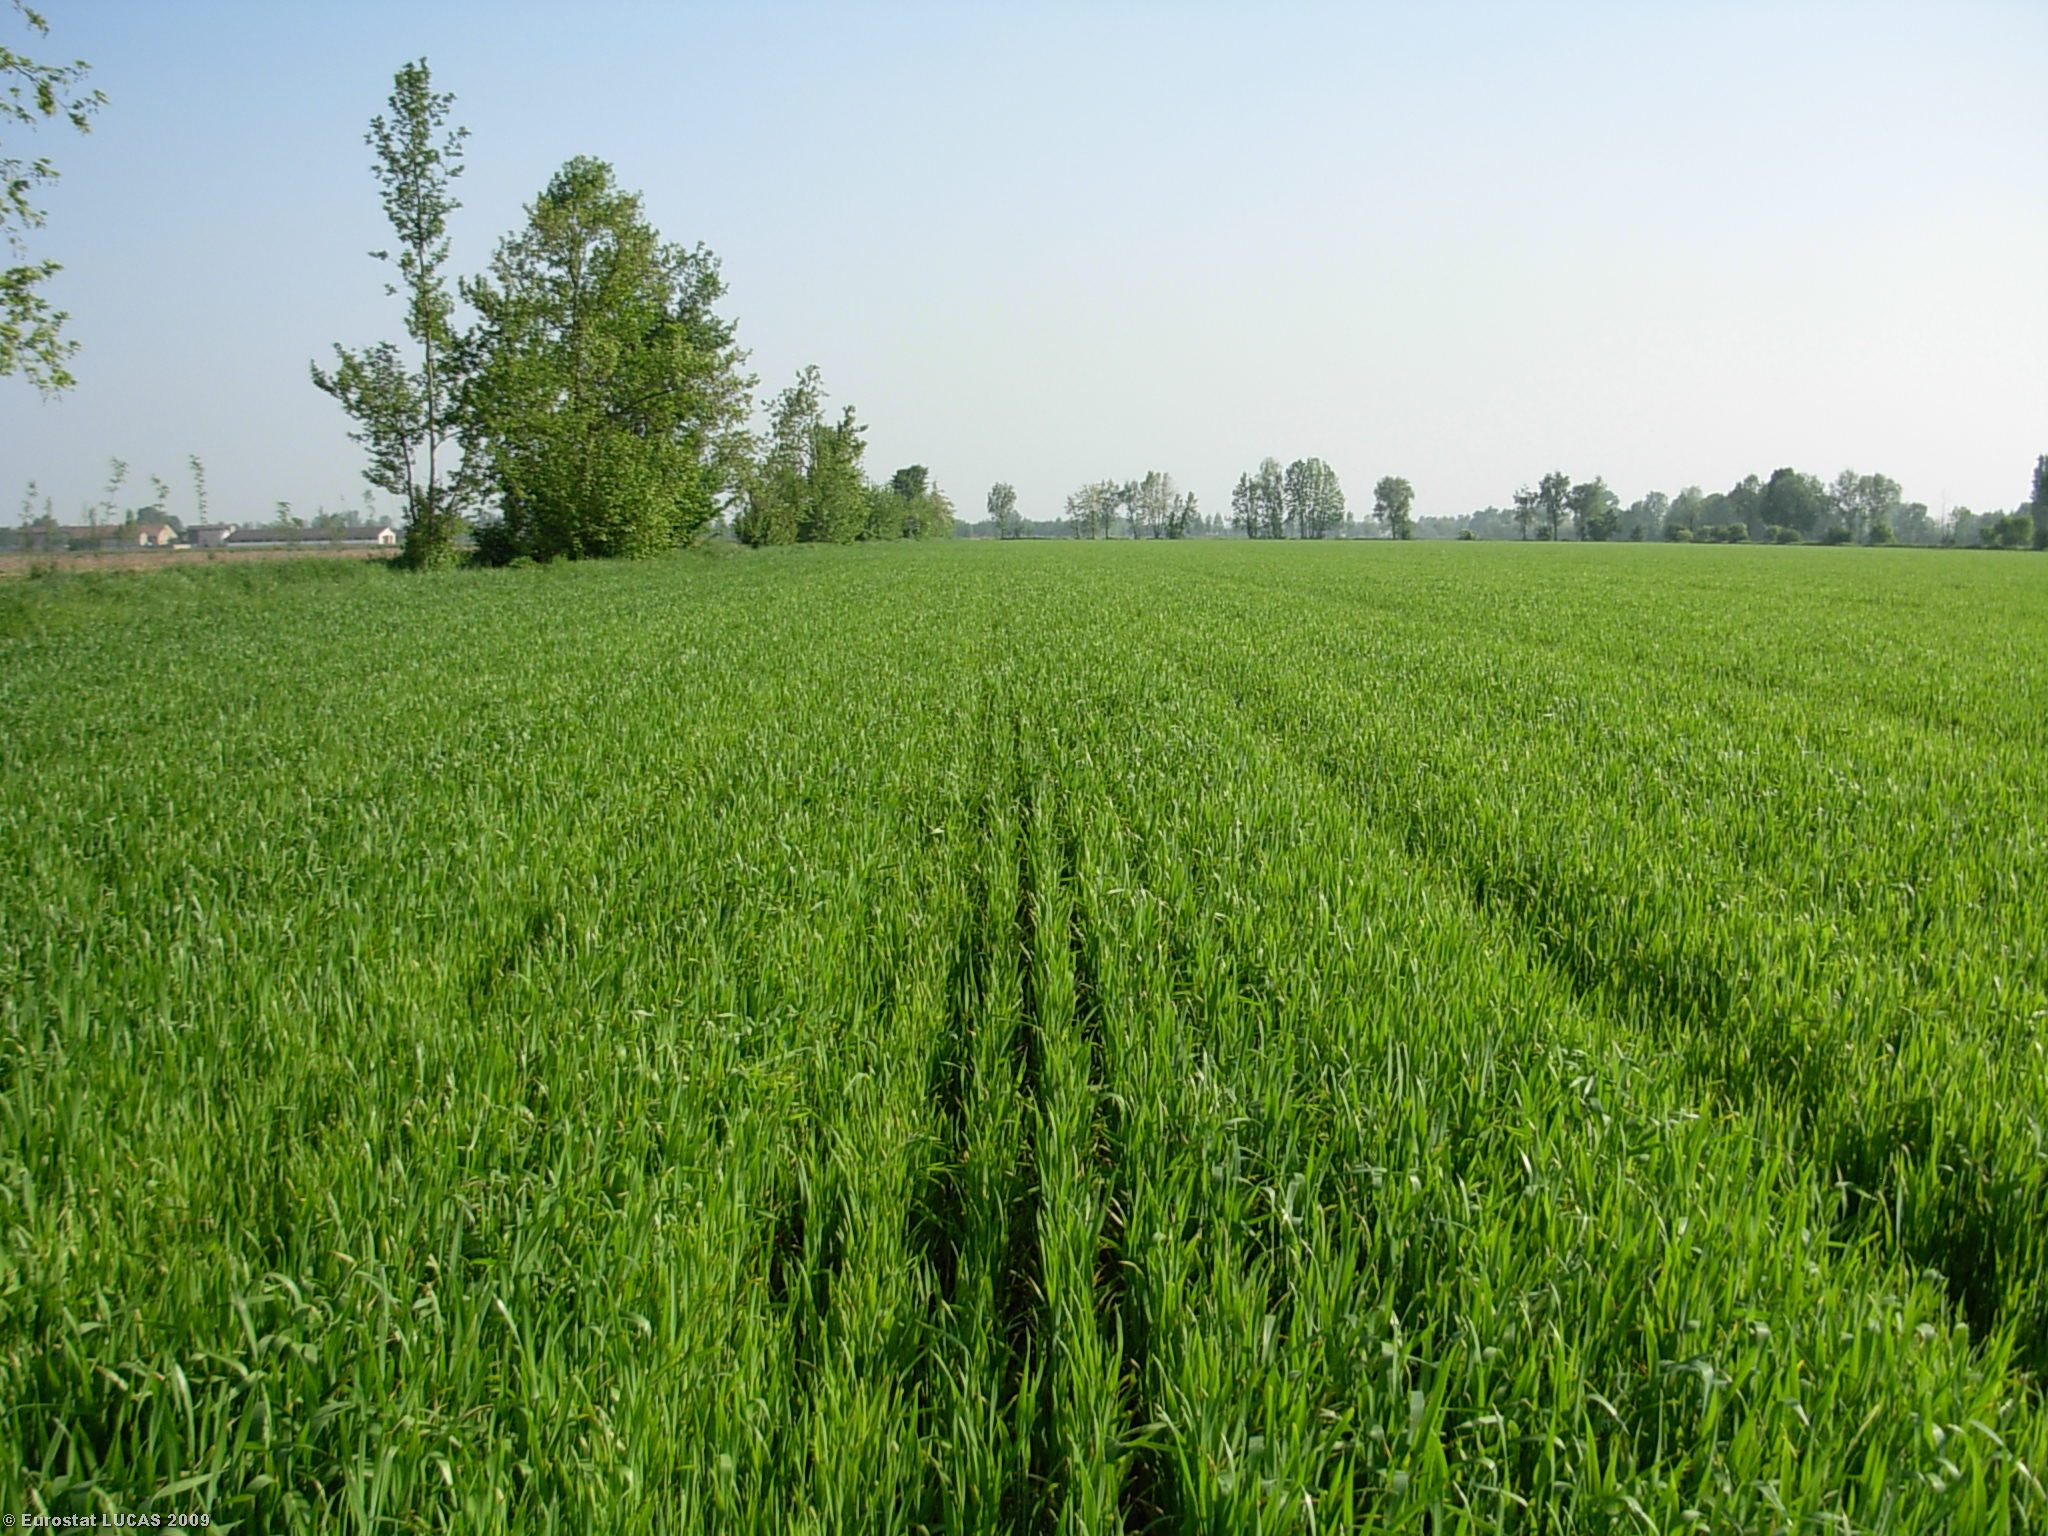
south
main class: Cropland
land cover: Common wheat
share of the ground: > 75 %
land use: Agriculture (excluding fallow land and kitchen gardens)
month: May
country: IT
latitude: 45.2698
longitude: 10.2672
